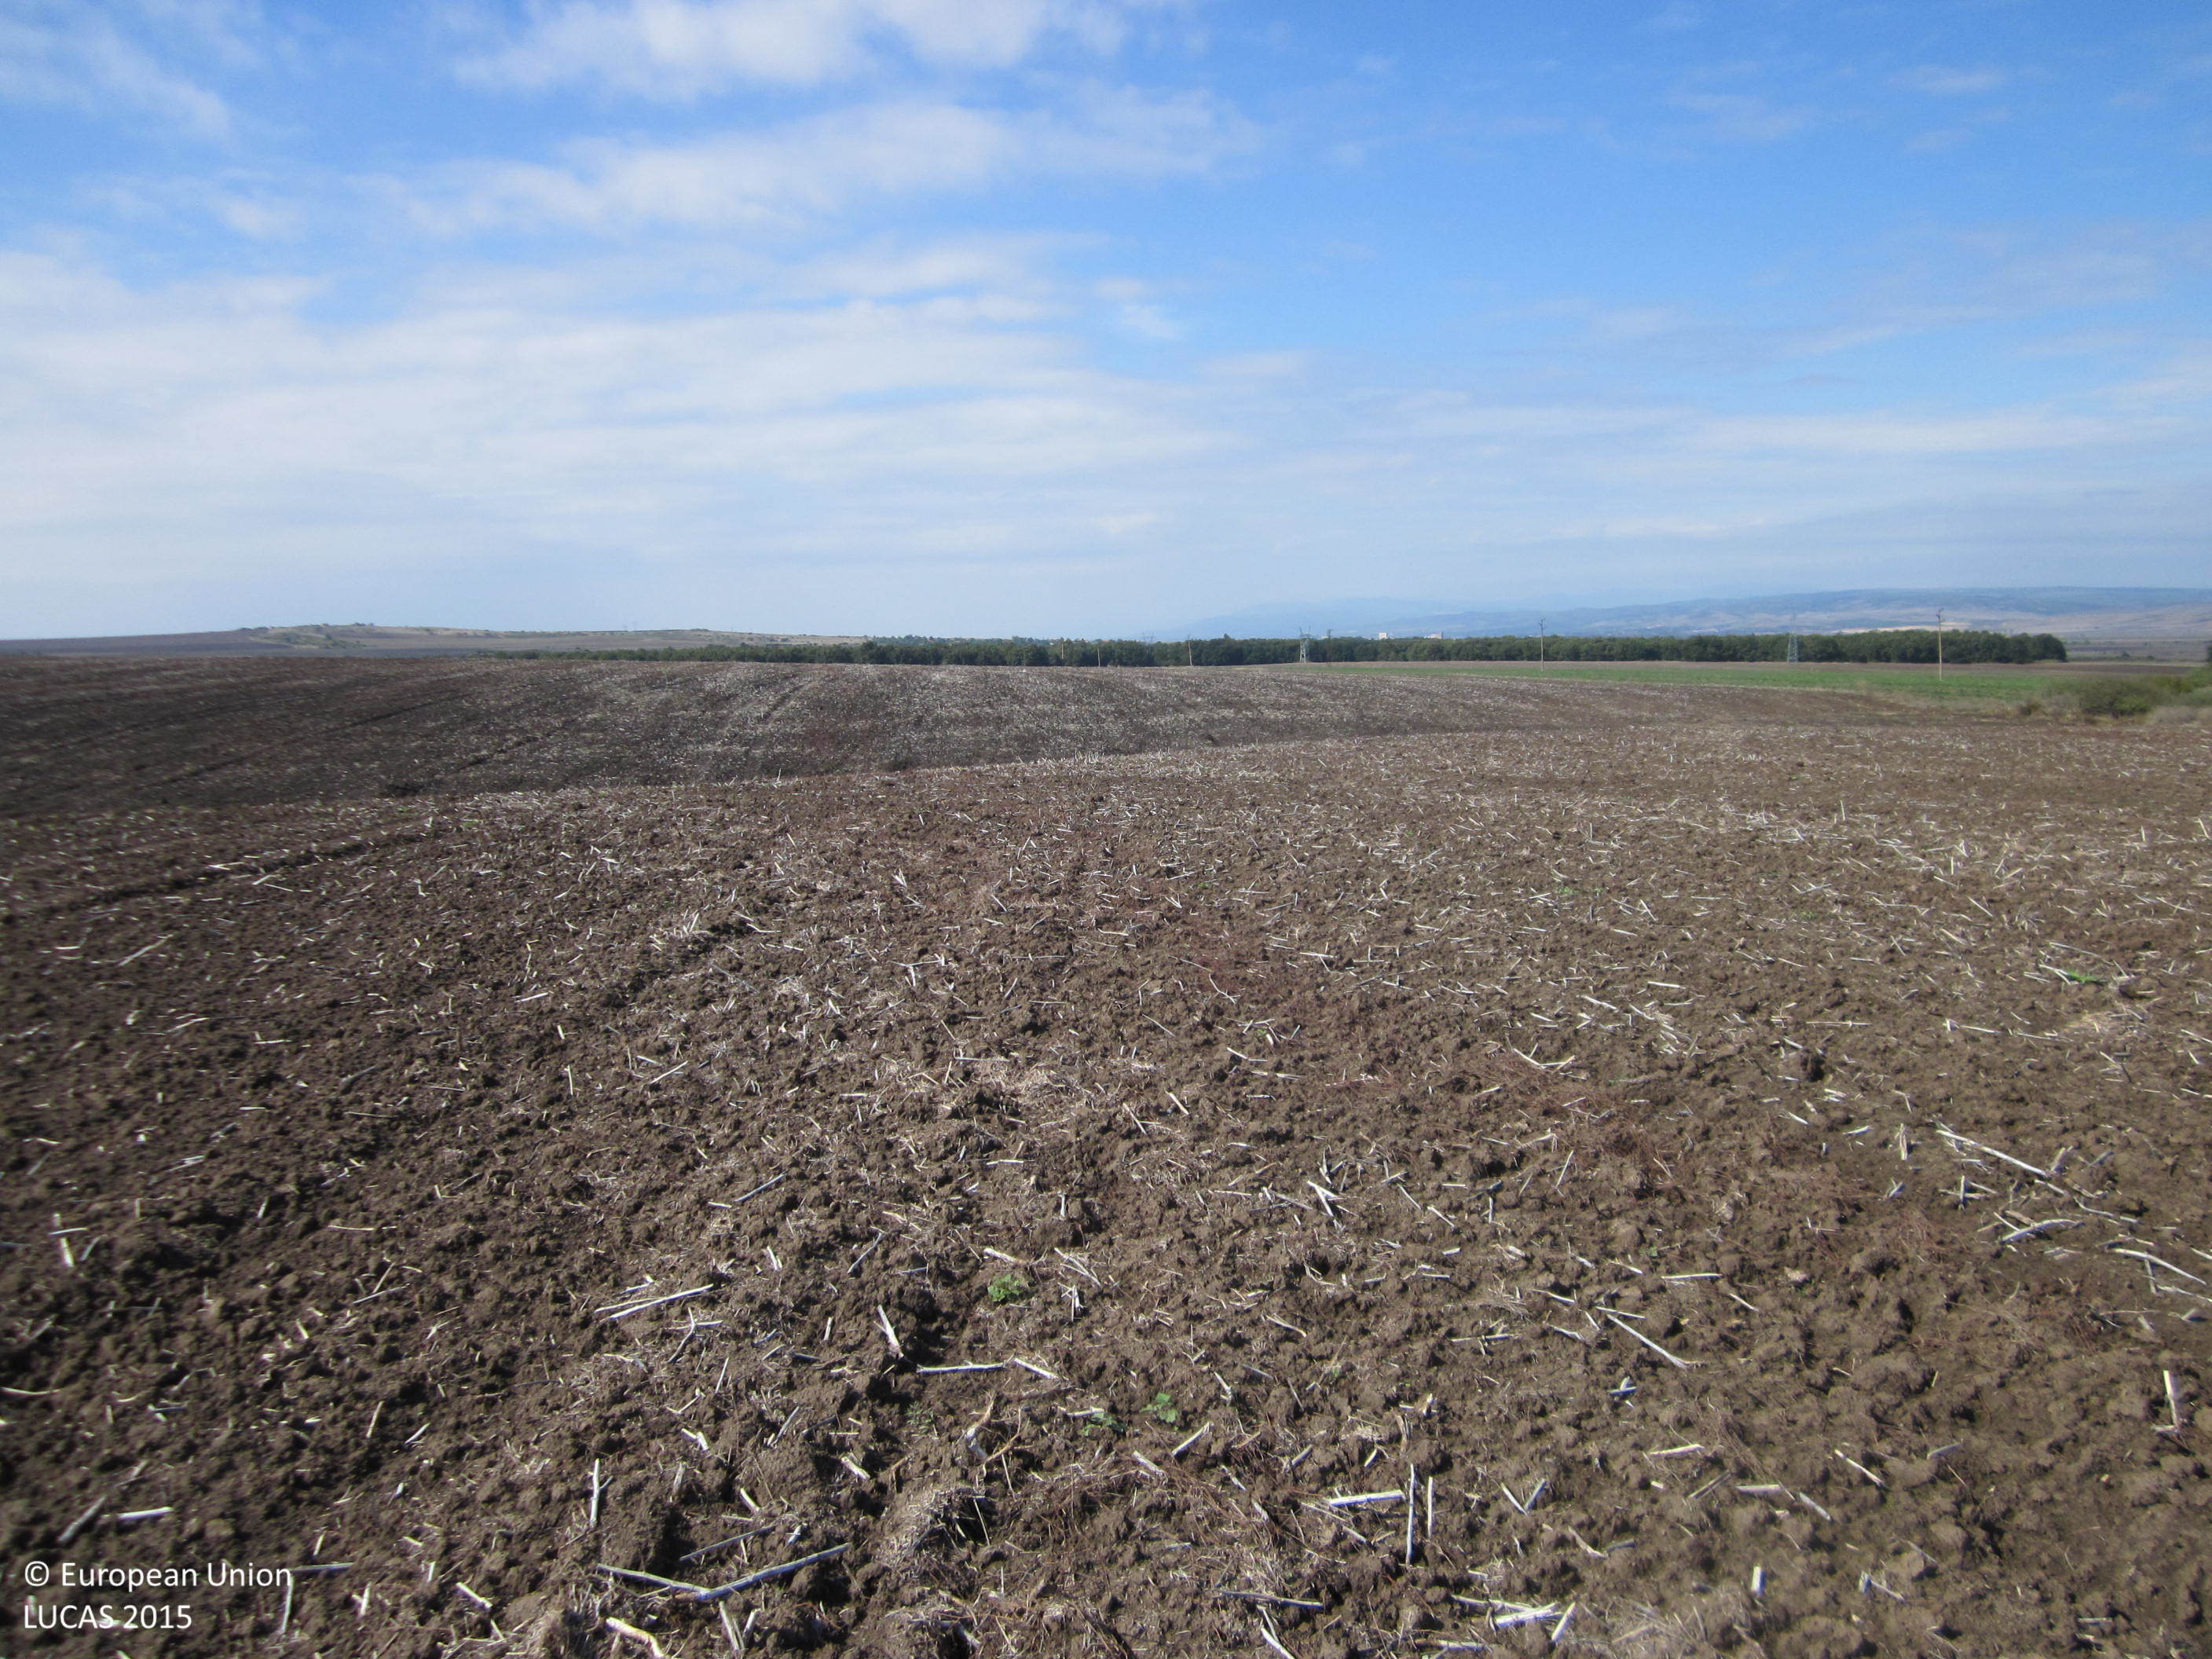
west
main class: Cropland
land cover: Sunflower
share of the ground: < 10 %
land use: Agriculture (excluding fallow land and kitchen gardens)
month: October
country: BG
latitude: 42.6006
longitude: 26.9111
